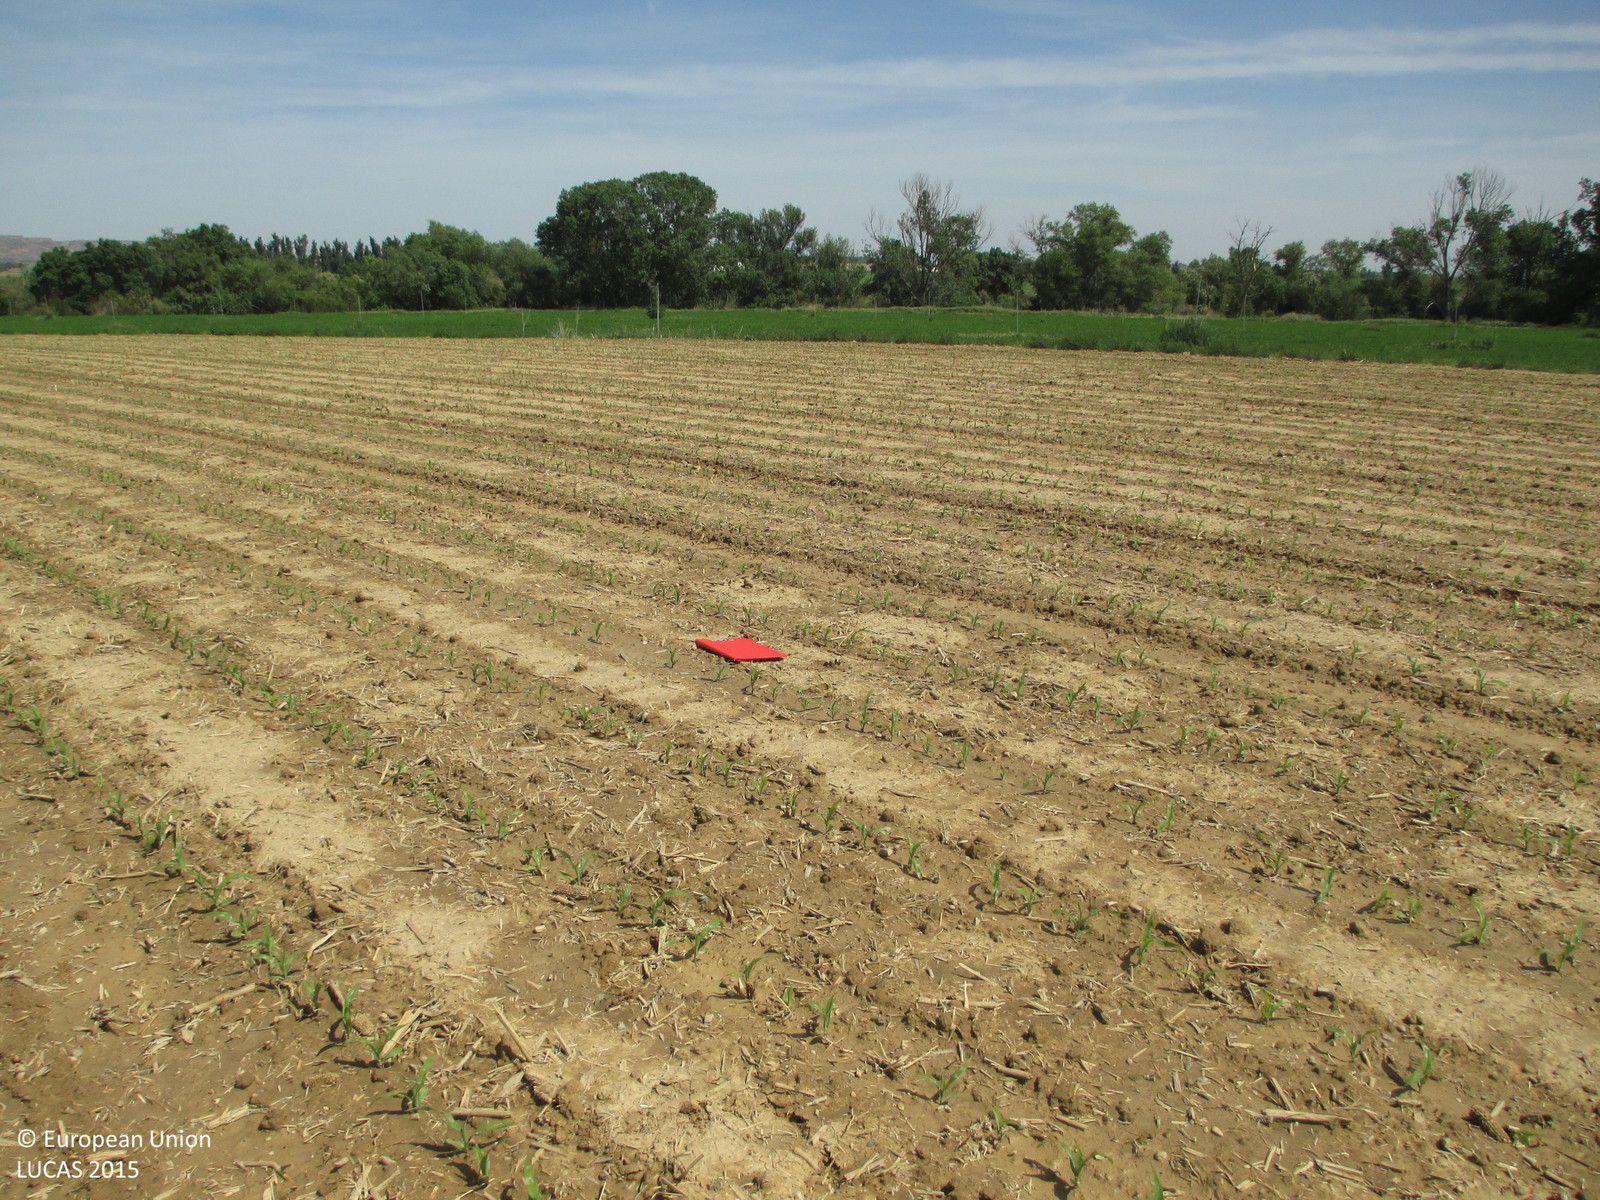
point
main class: Cropland
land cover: Maize
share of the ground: 10 - 25 %
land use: Agriculture (excluding fallow land and kitchen gardens)
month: May
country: ES
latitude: 41.9218
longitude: -0.3541
